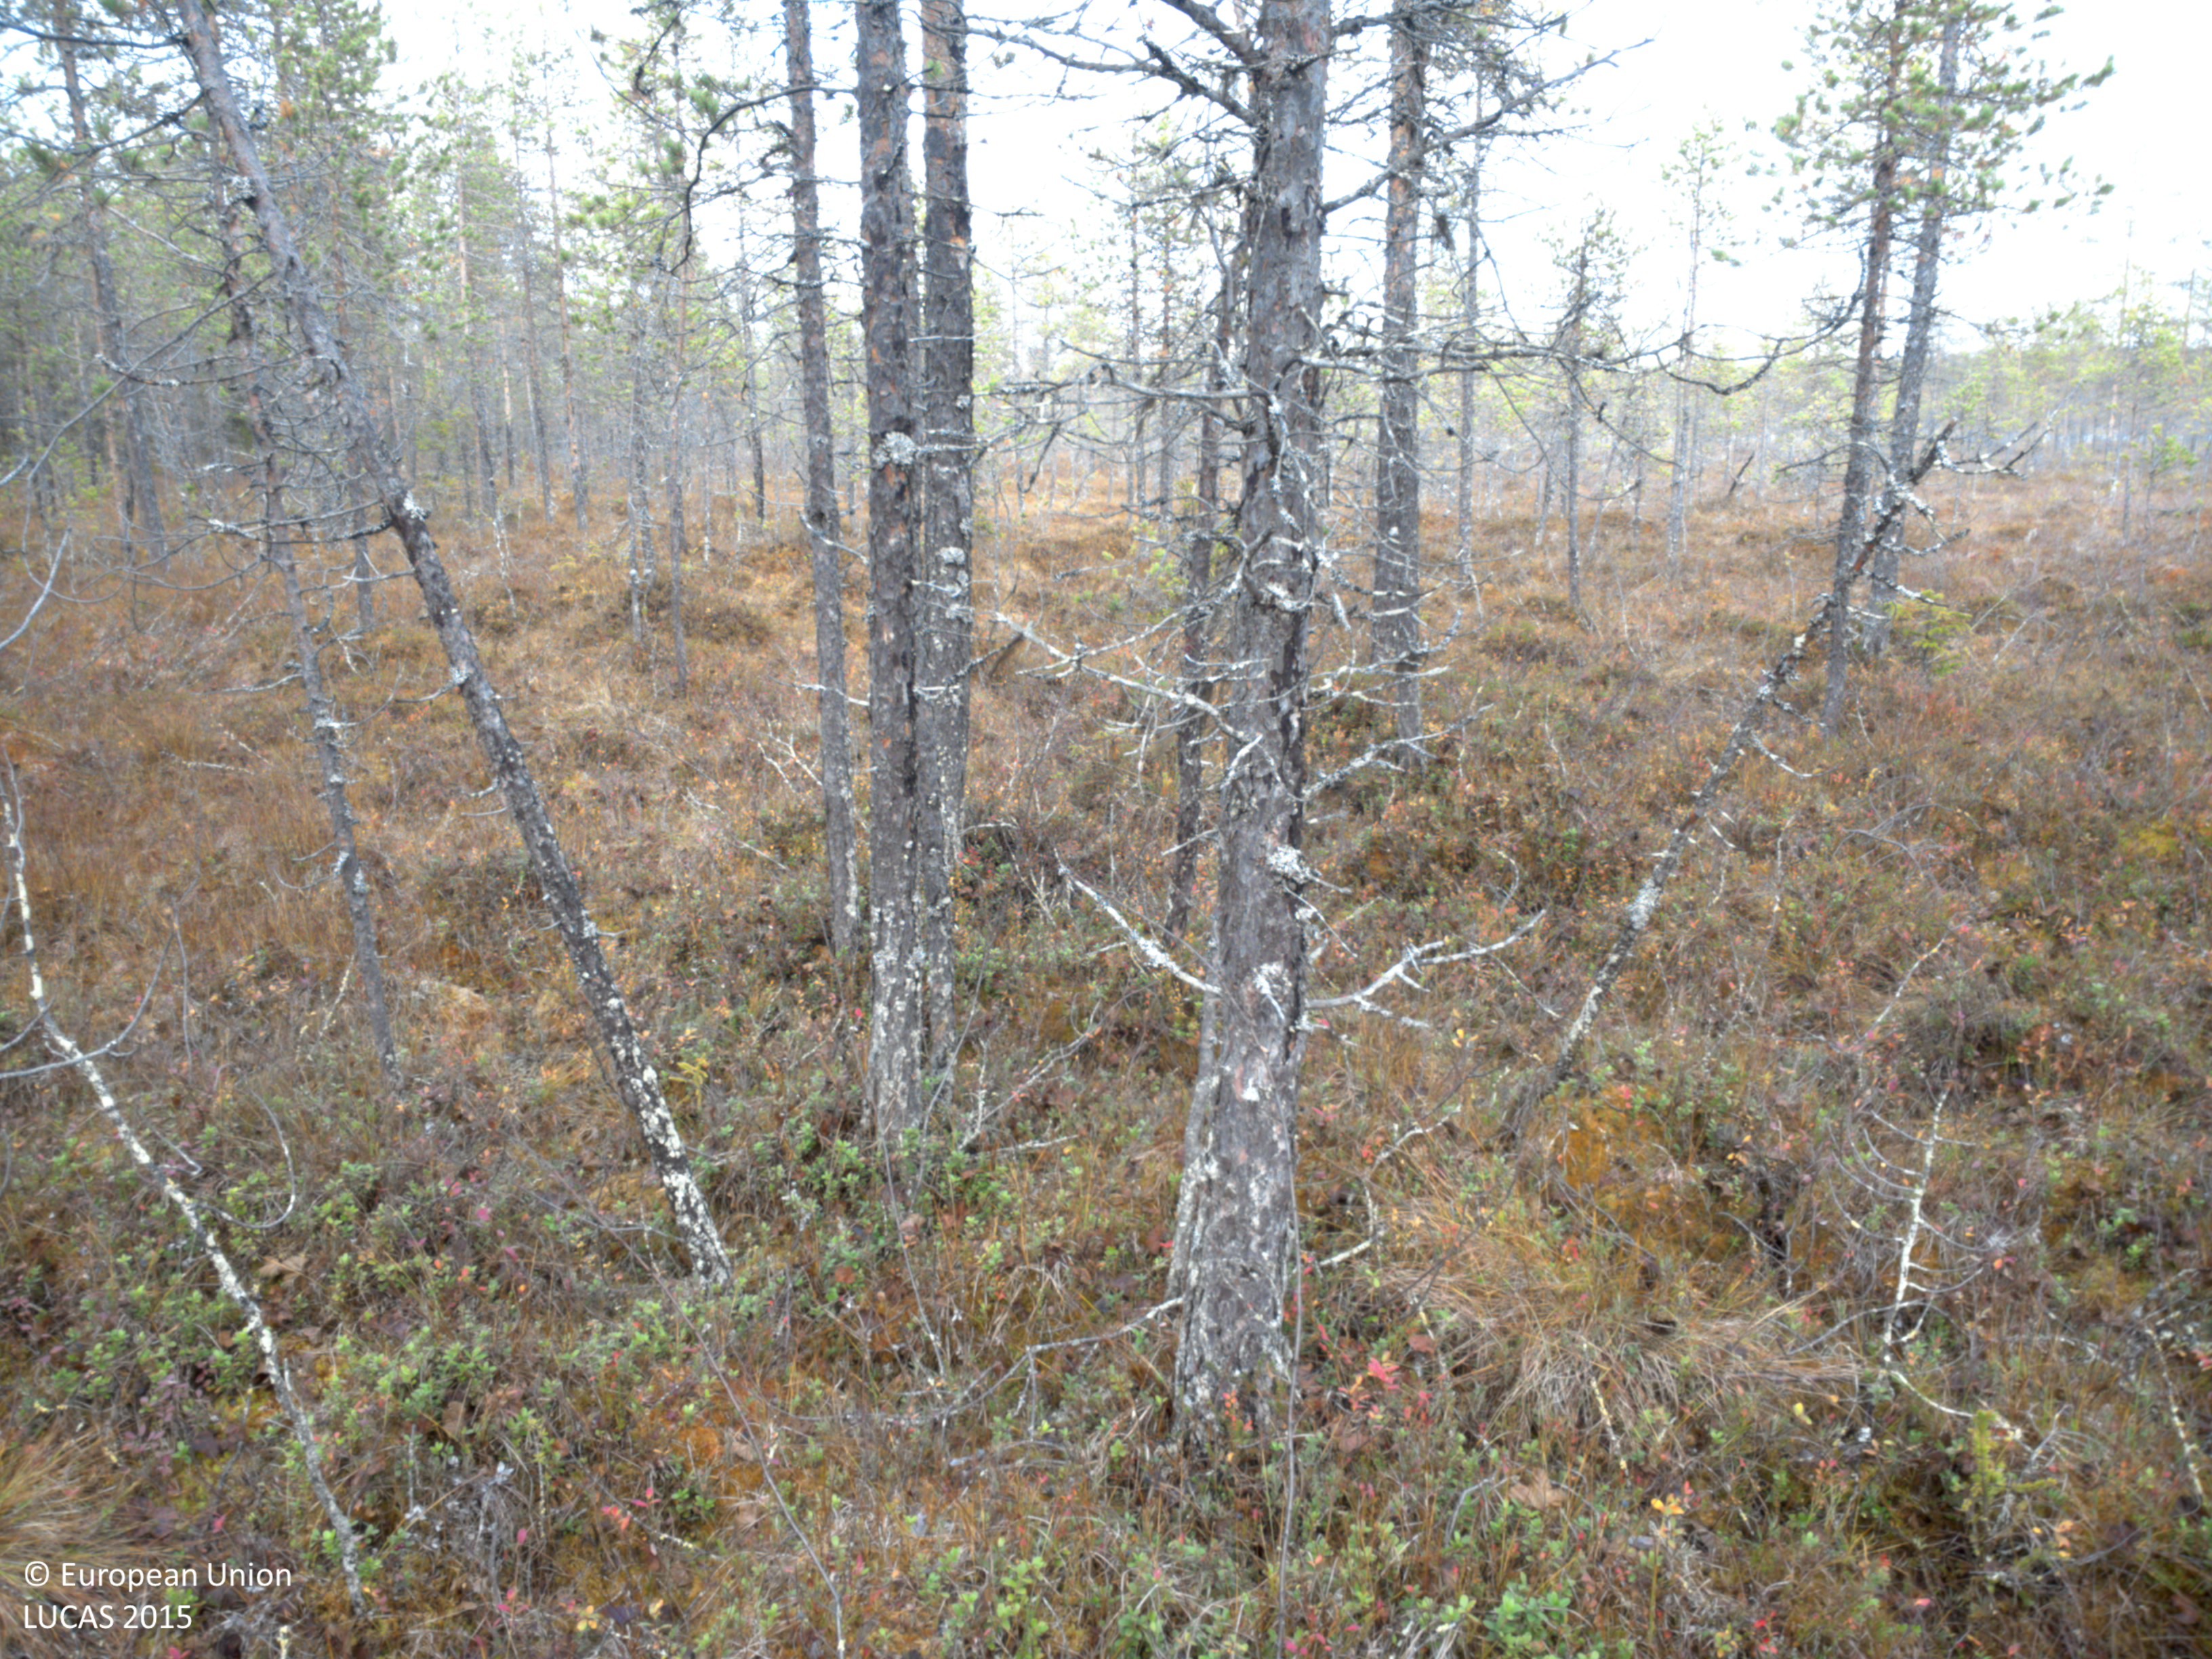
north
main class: Woodland
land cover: Pine dominated coniferous woodland
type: boreal forest
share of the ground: 25 - 50 %
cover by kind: coniferous forest trees 50 %, shrubs 20 %, herbaceous plants 20 %, lichens and mosses 10 %
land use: Forestry
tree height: > 5 m
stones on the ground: < 10 %
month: September
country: SE
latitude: 64.9701
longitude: 18.8409
